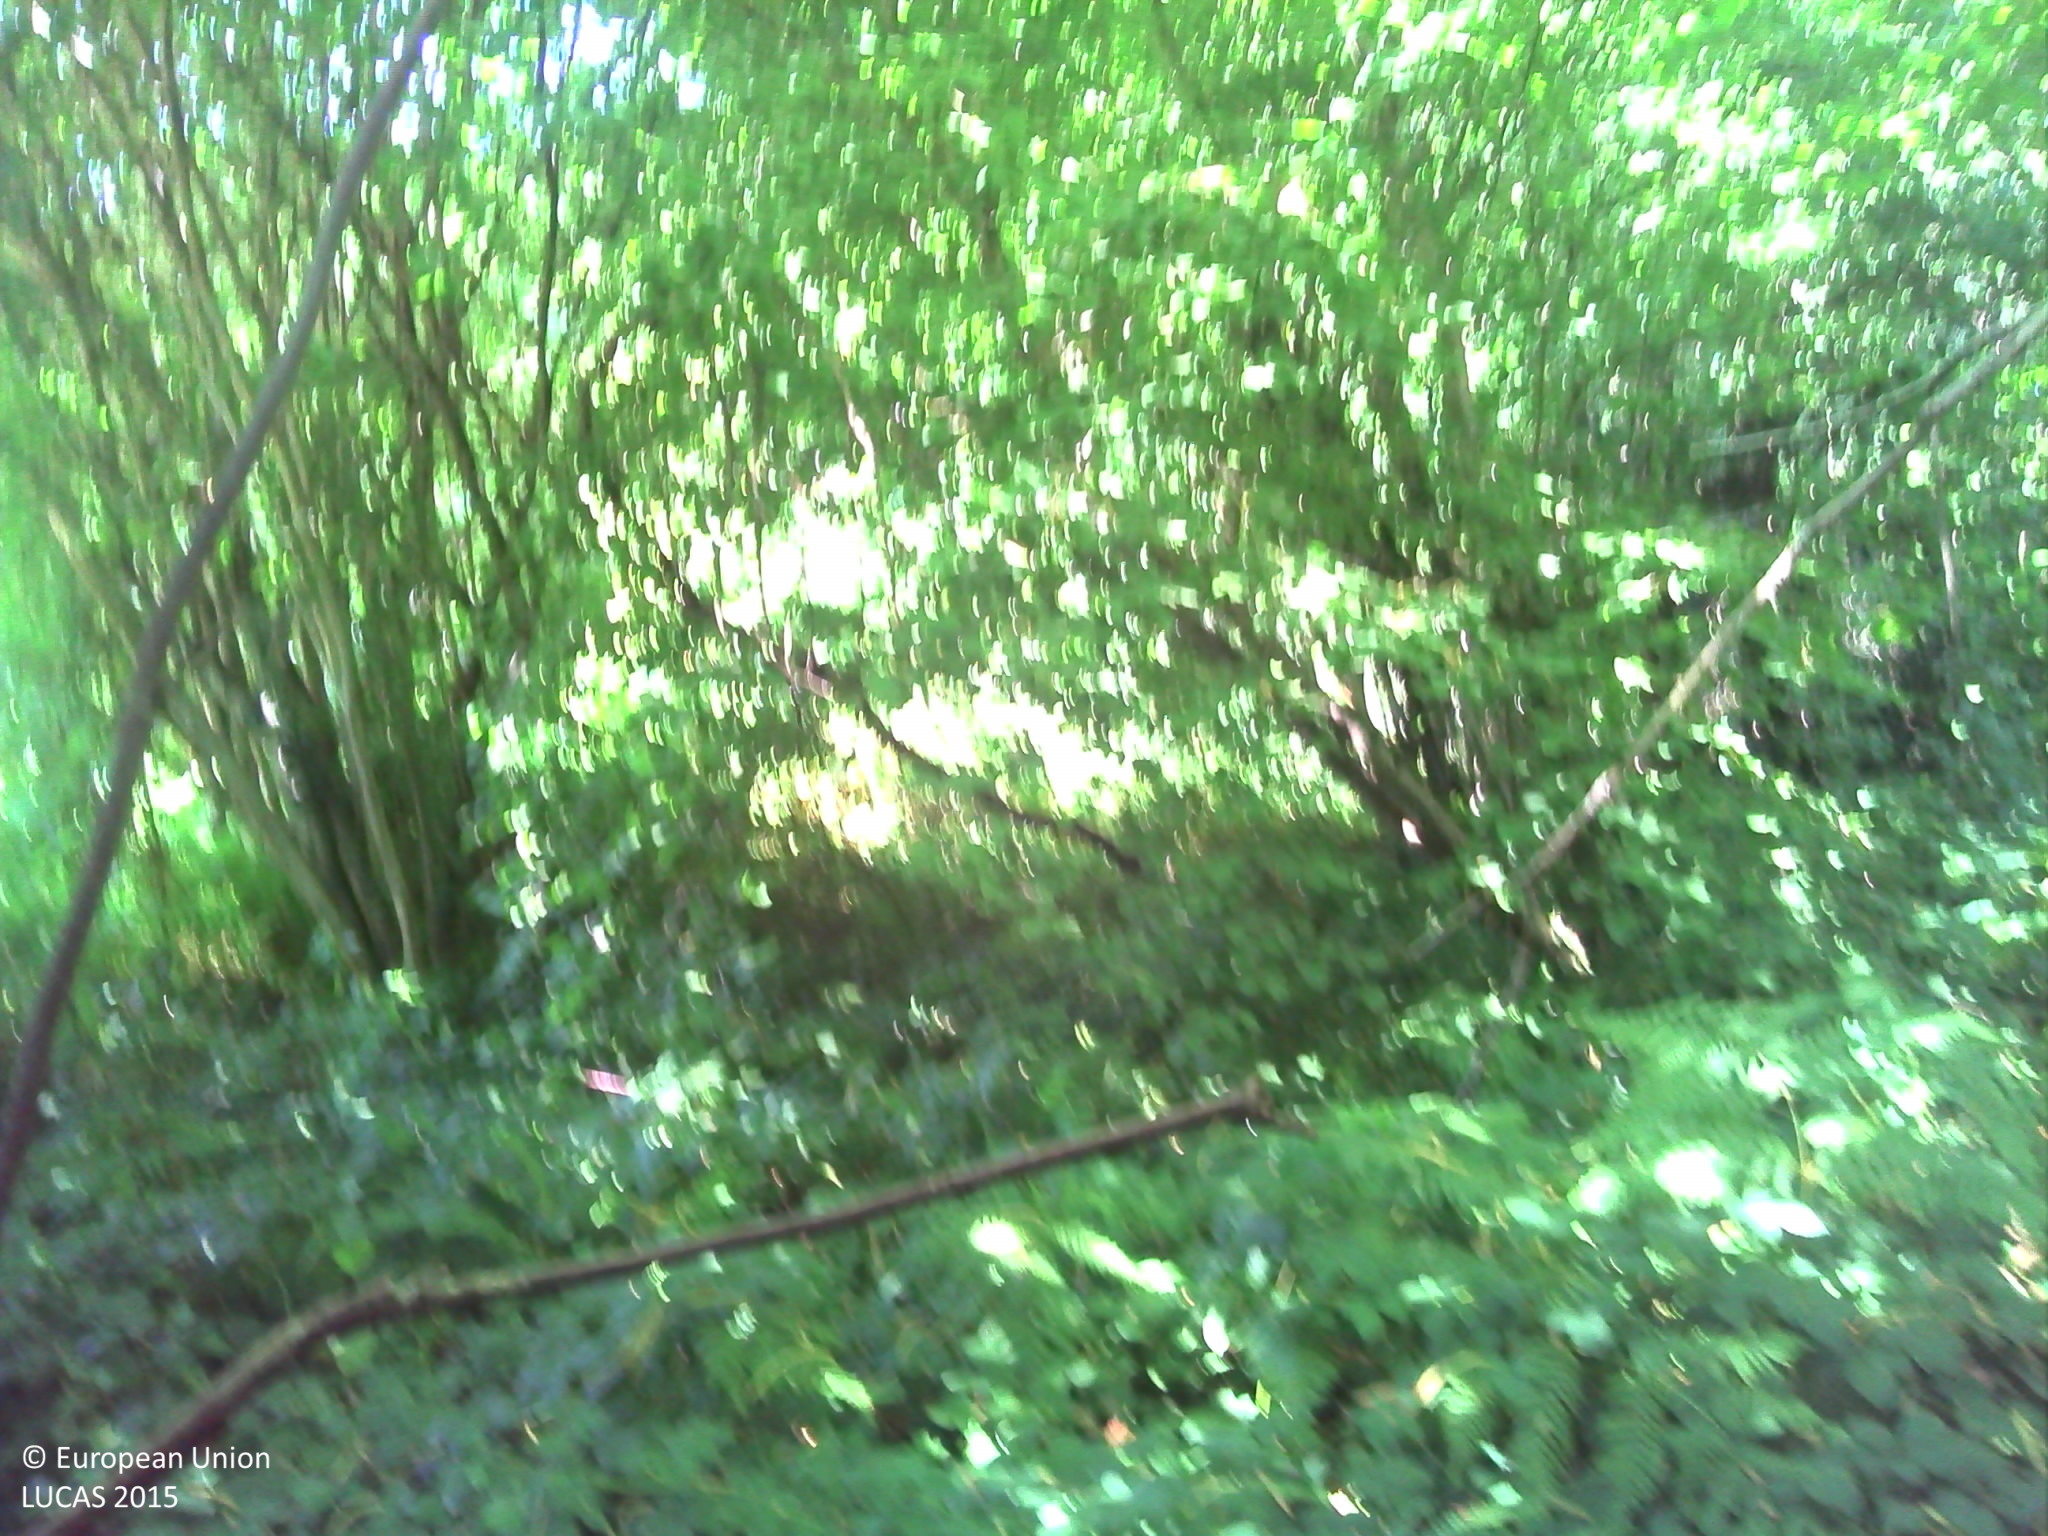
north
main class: Woodland
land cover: Broadleaved woodland
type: mesophytic deciduous forest
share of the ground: > 75 %
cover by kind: broadleaved forest trees 90 %, coniferous forest trees 5 %, lichens and mosses 5 %
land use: Forestry
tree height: > 5 m
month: July
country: FR
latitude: 46.1583
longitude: 1.7436
